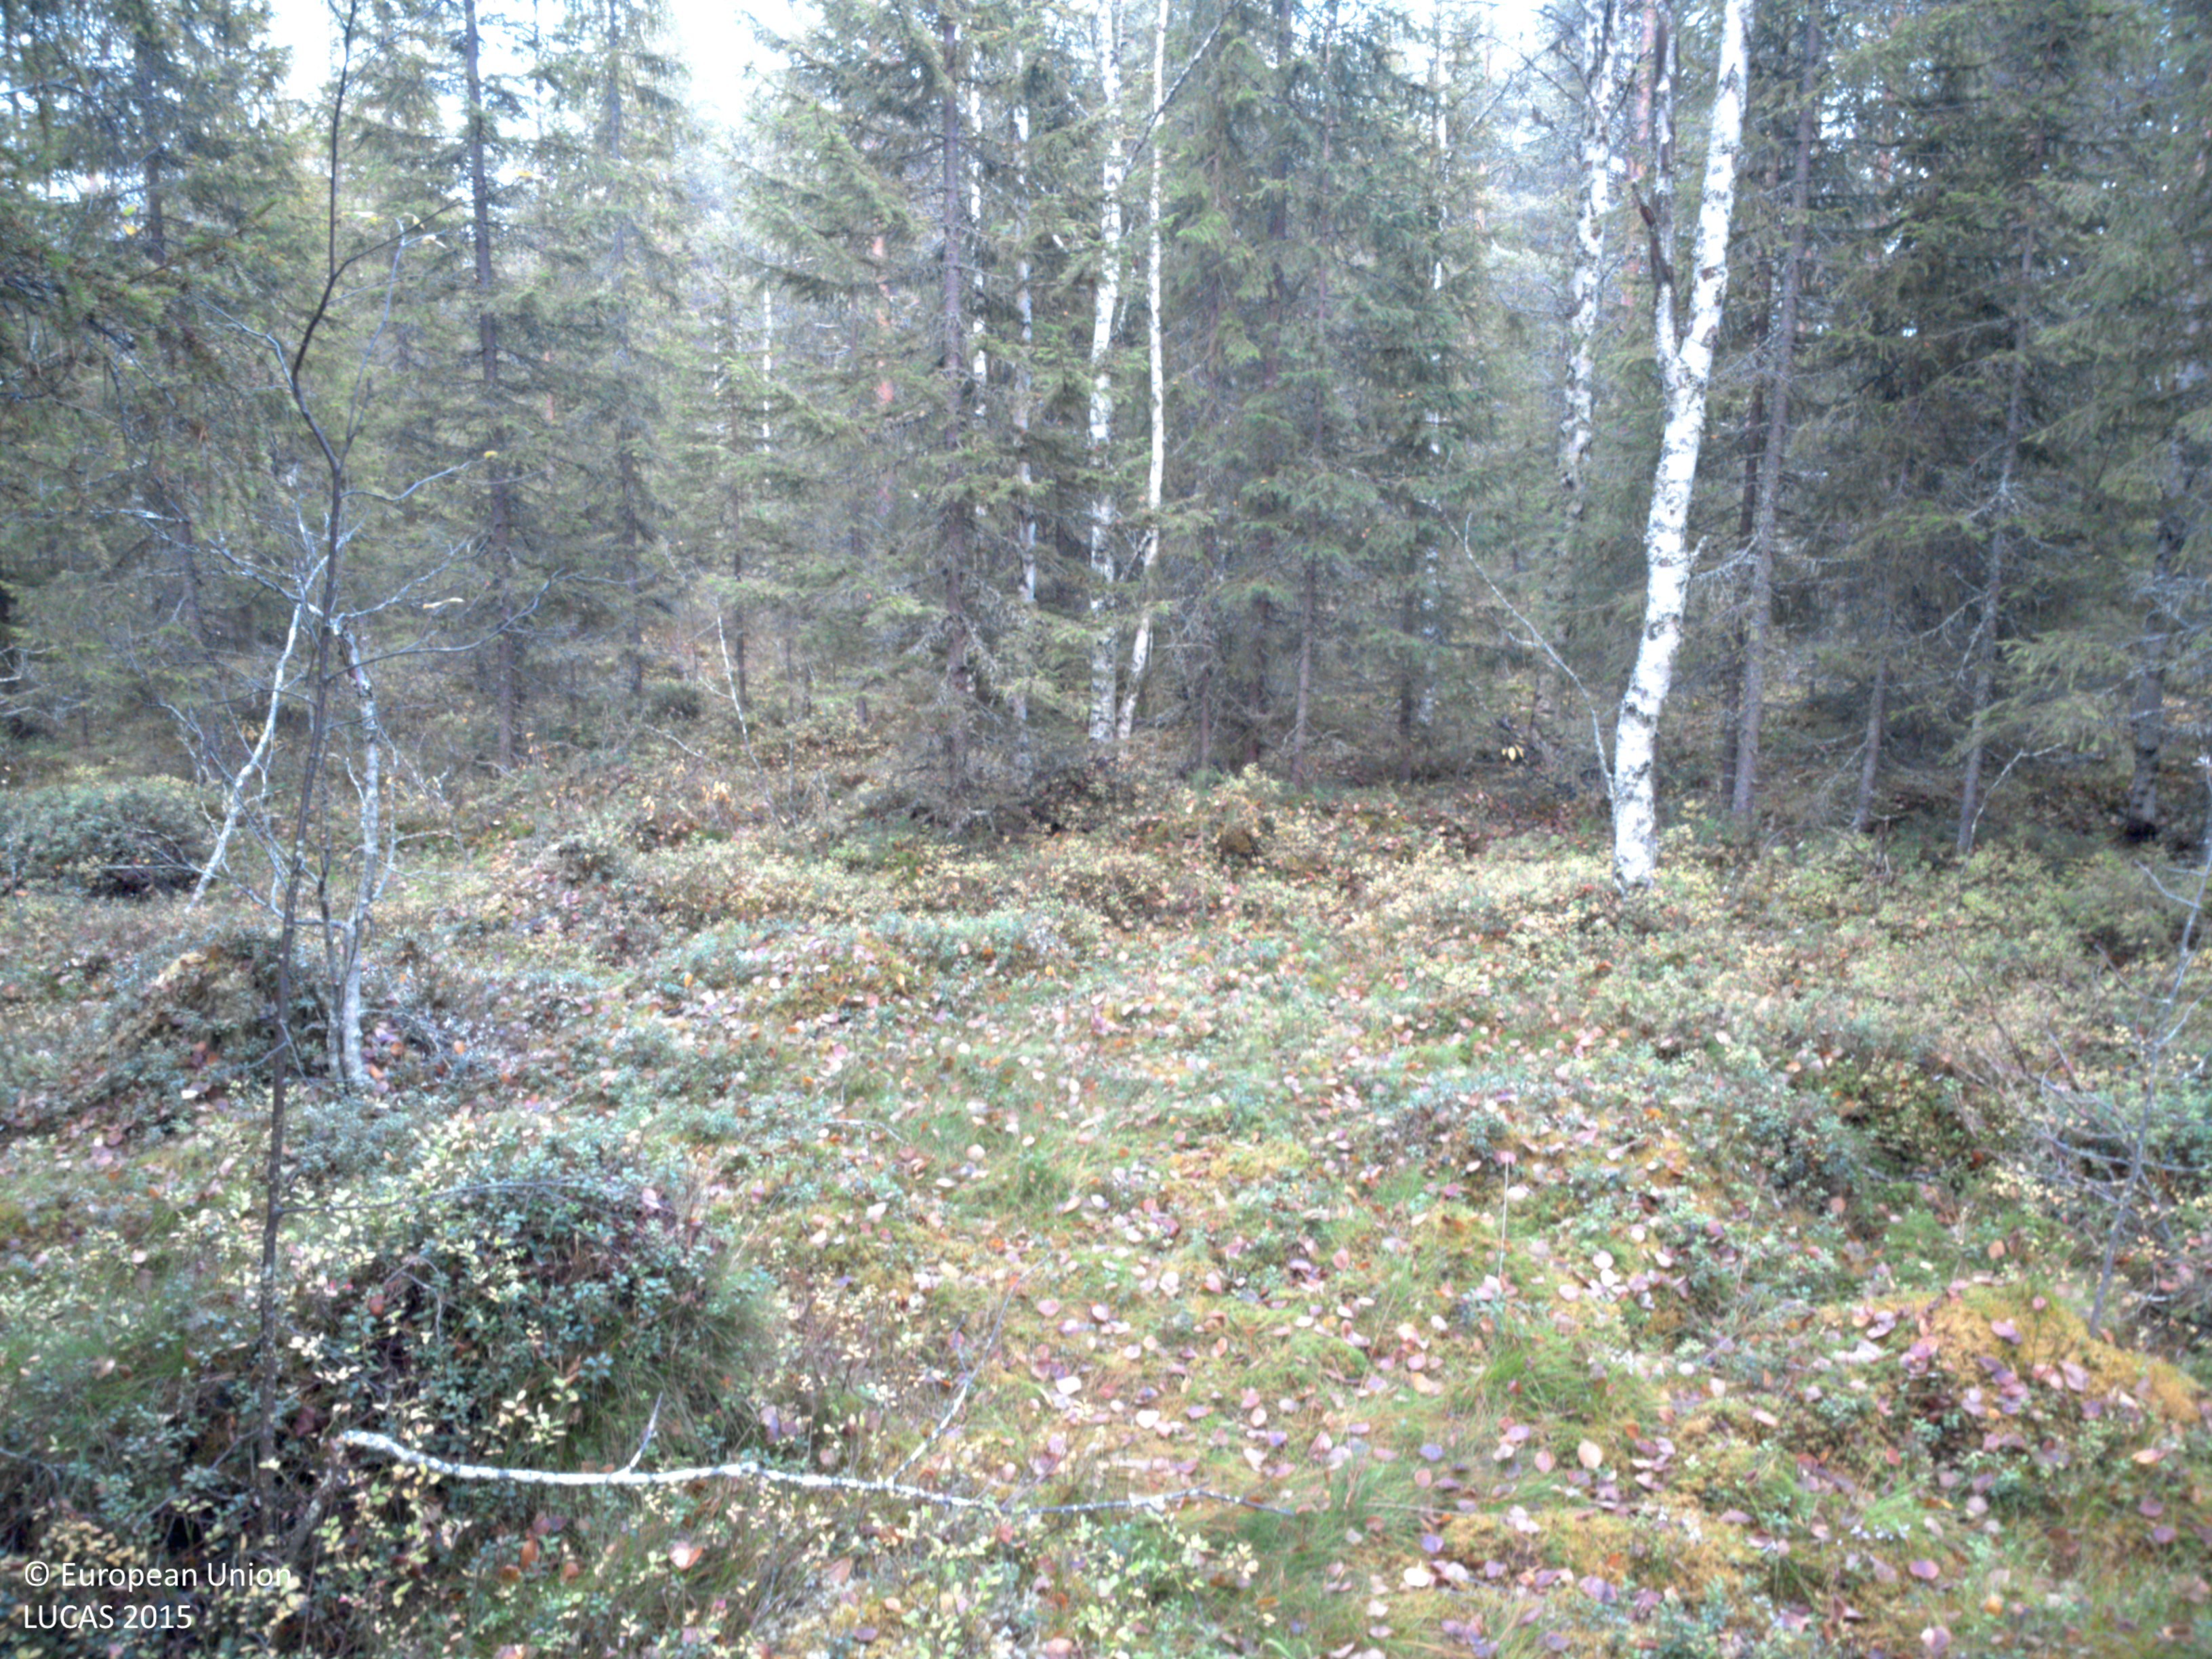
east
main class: Woodland
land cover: Pine dominated mixed woodland
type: boreal forest
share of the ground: > 75 %
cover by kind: coniferous forest trees 60 %, broadleaved forest trees 20 %, shrubs 15 %, lichens and mosses 5 %
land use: Forestry
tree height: > 5 m
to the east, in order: Pine dominated mixed woodland; Other mixed woodland; Spruce dominated mixed woodland; Pine dominated mixed woodland
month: September
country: SE
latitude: 65.0373
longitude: 18.6073
